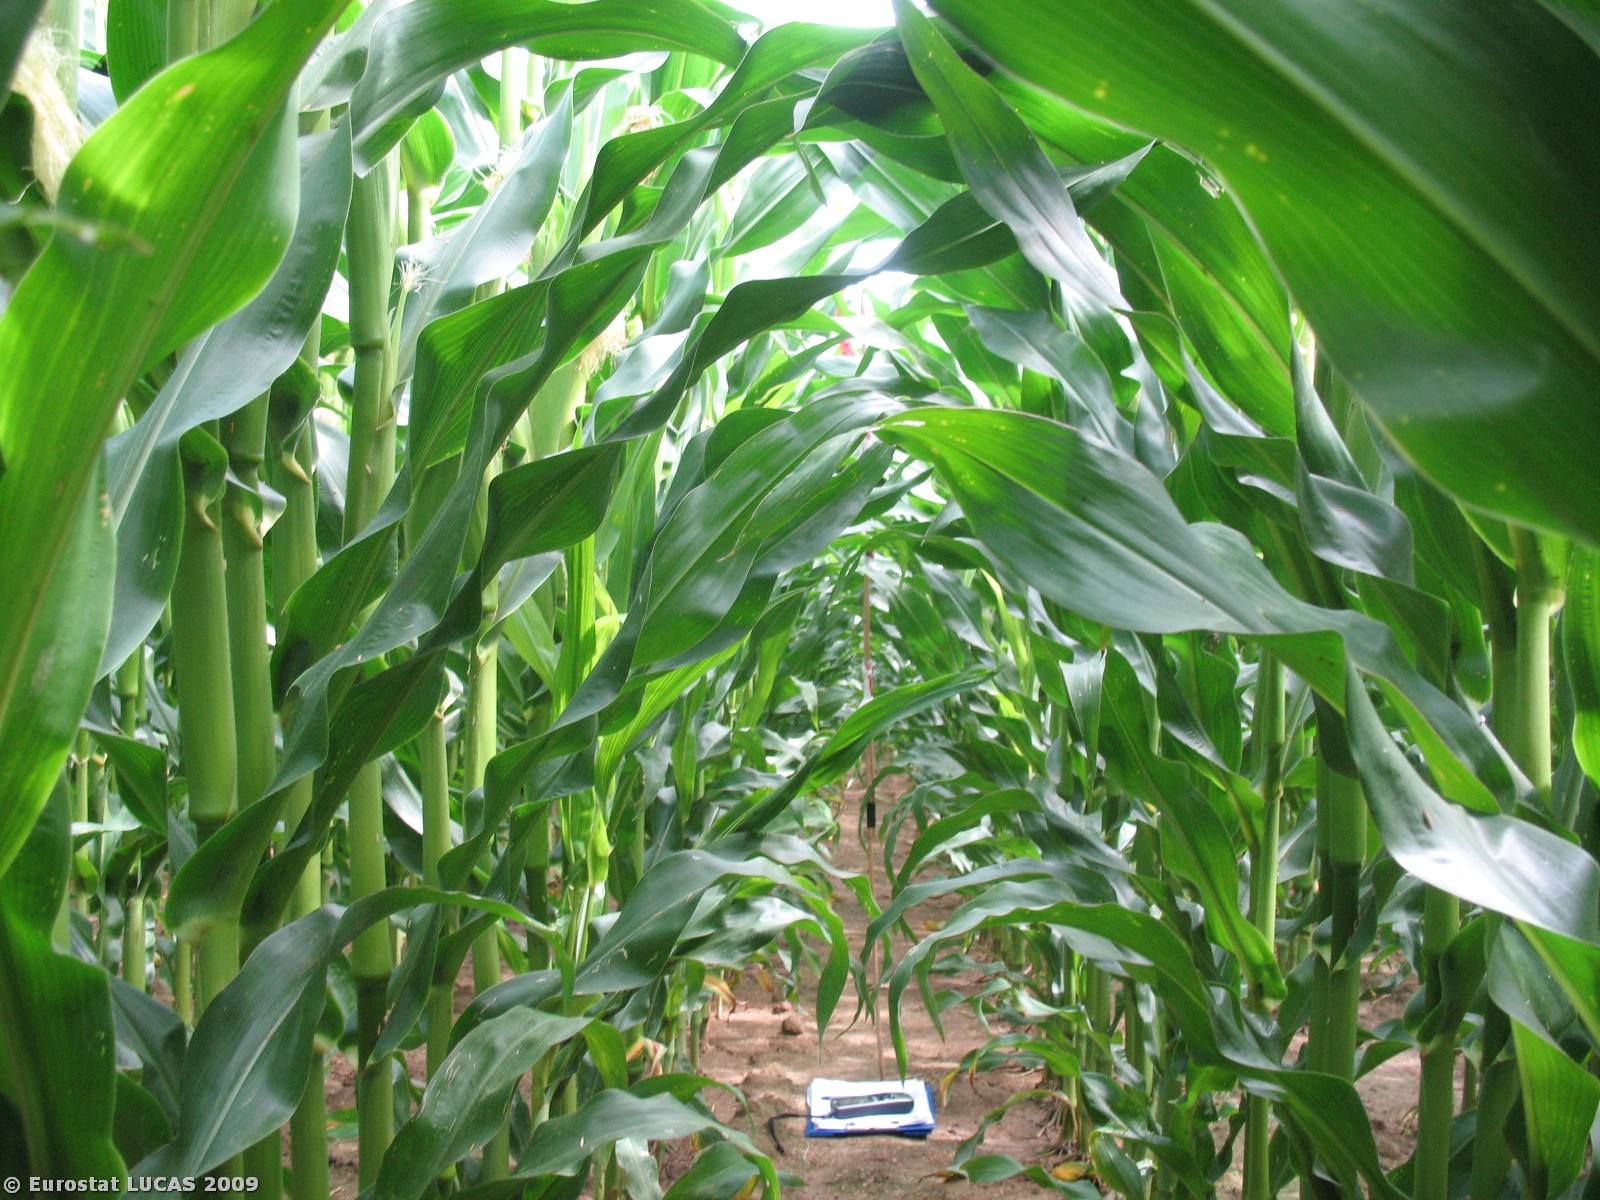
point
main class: Cropland
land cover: Maize
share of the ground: > 75 %
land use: Agriculture (excluding fallow land and kitchen gardens)
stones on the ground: < 10 %
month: July
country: BE
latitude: 50.8592
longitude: 3.7280
